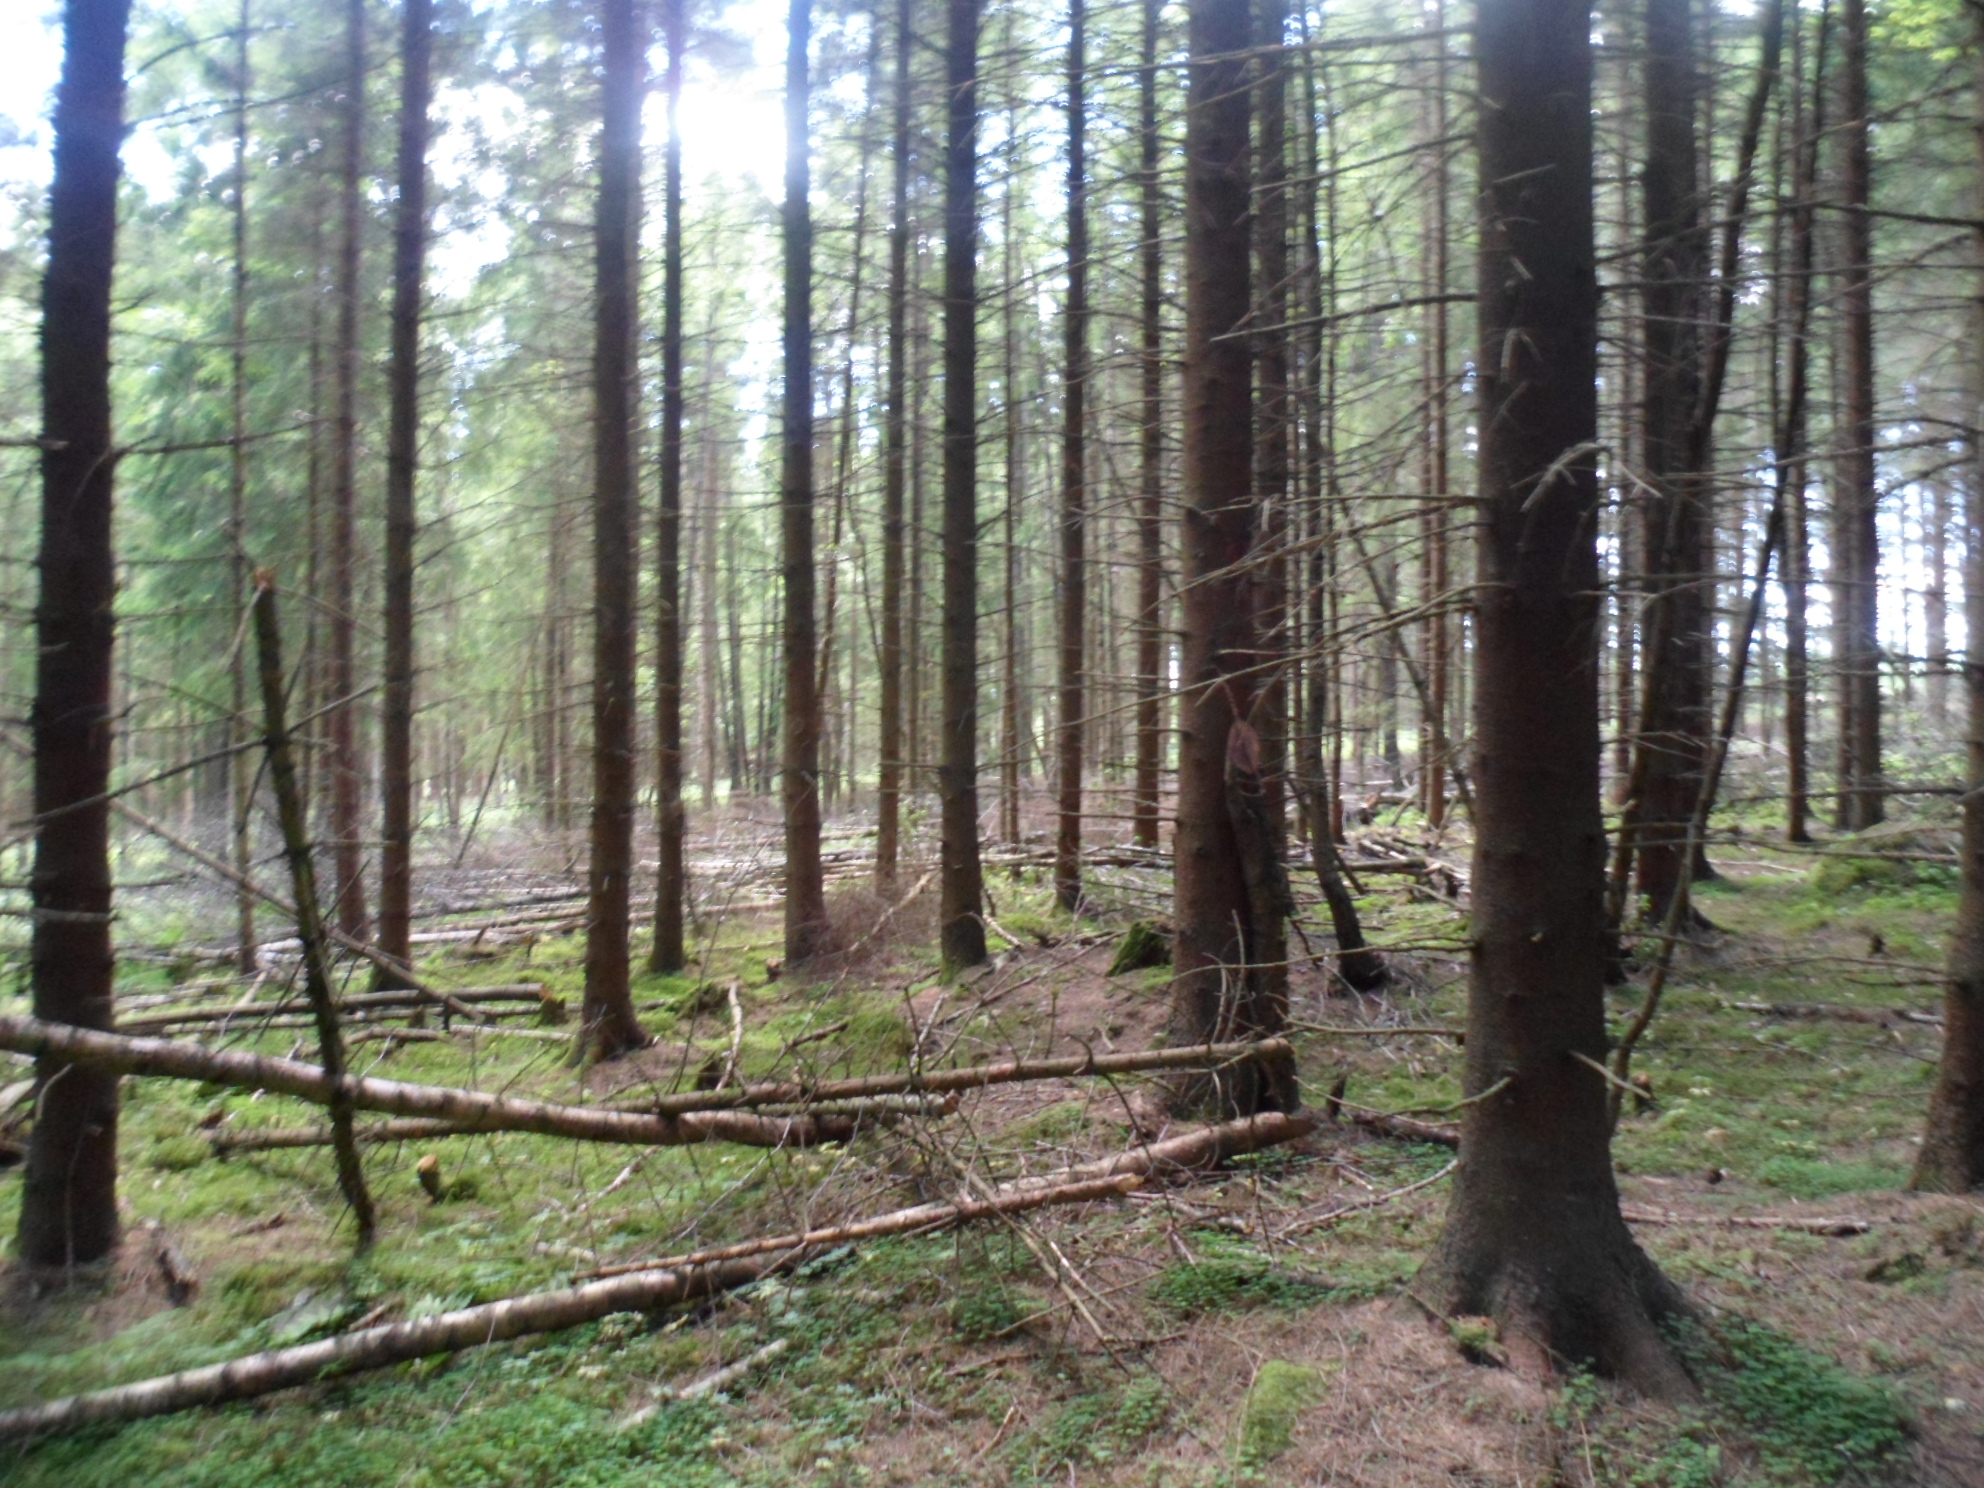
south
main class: Woodland
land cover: Spruce dominated coniferous woodland
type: boreal forest
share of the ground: > 75 %
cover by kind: coniferous forest trees 80 %, herbaceous plants 10 %, lichens and mosses 5 %, unconsolidated bare surface 5 %
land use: Forestry
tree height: > 5 m
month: July
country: SE
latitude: 57.4413
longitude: 14.5108
